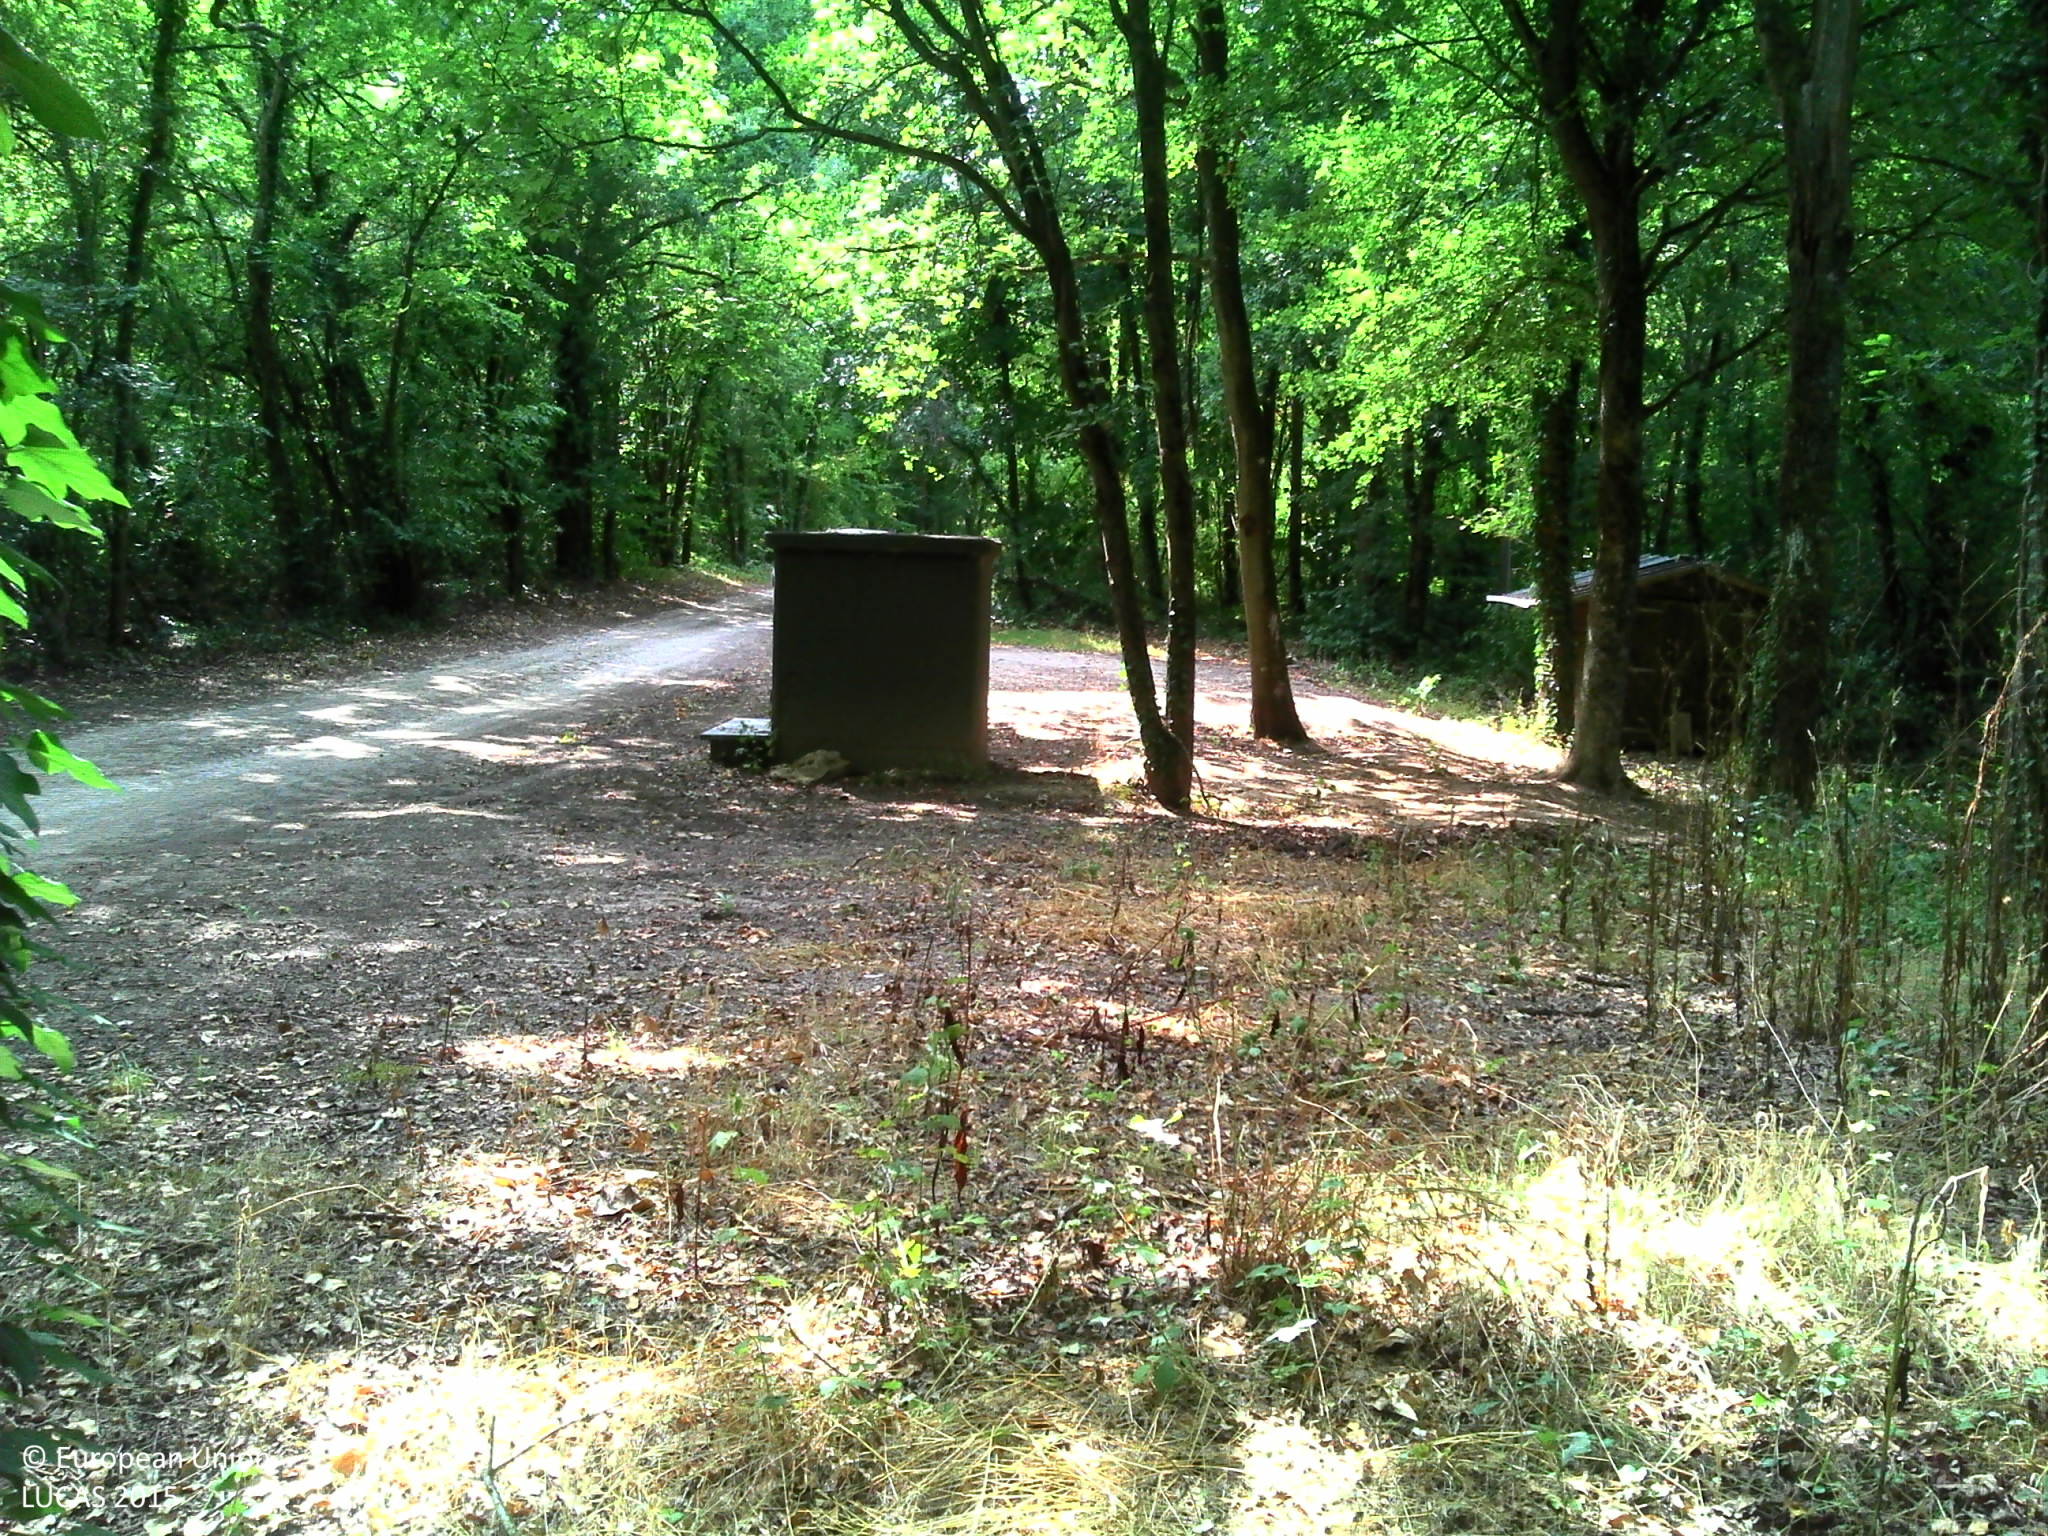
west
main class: Woodland
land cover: Broadleaved woodland
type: beech forest
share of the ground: > 75 %
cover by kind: broadleaved forest trees 55 %, herbaceous plants 35 %, shrubs 5 %, unconsolidated bare surface 5 %
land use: Residential
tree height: > 5 m
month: August
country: FR
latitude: 48.3635
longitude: 2.4714
